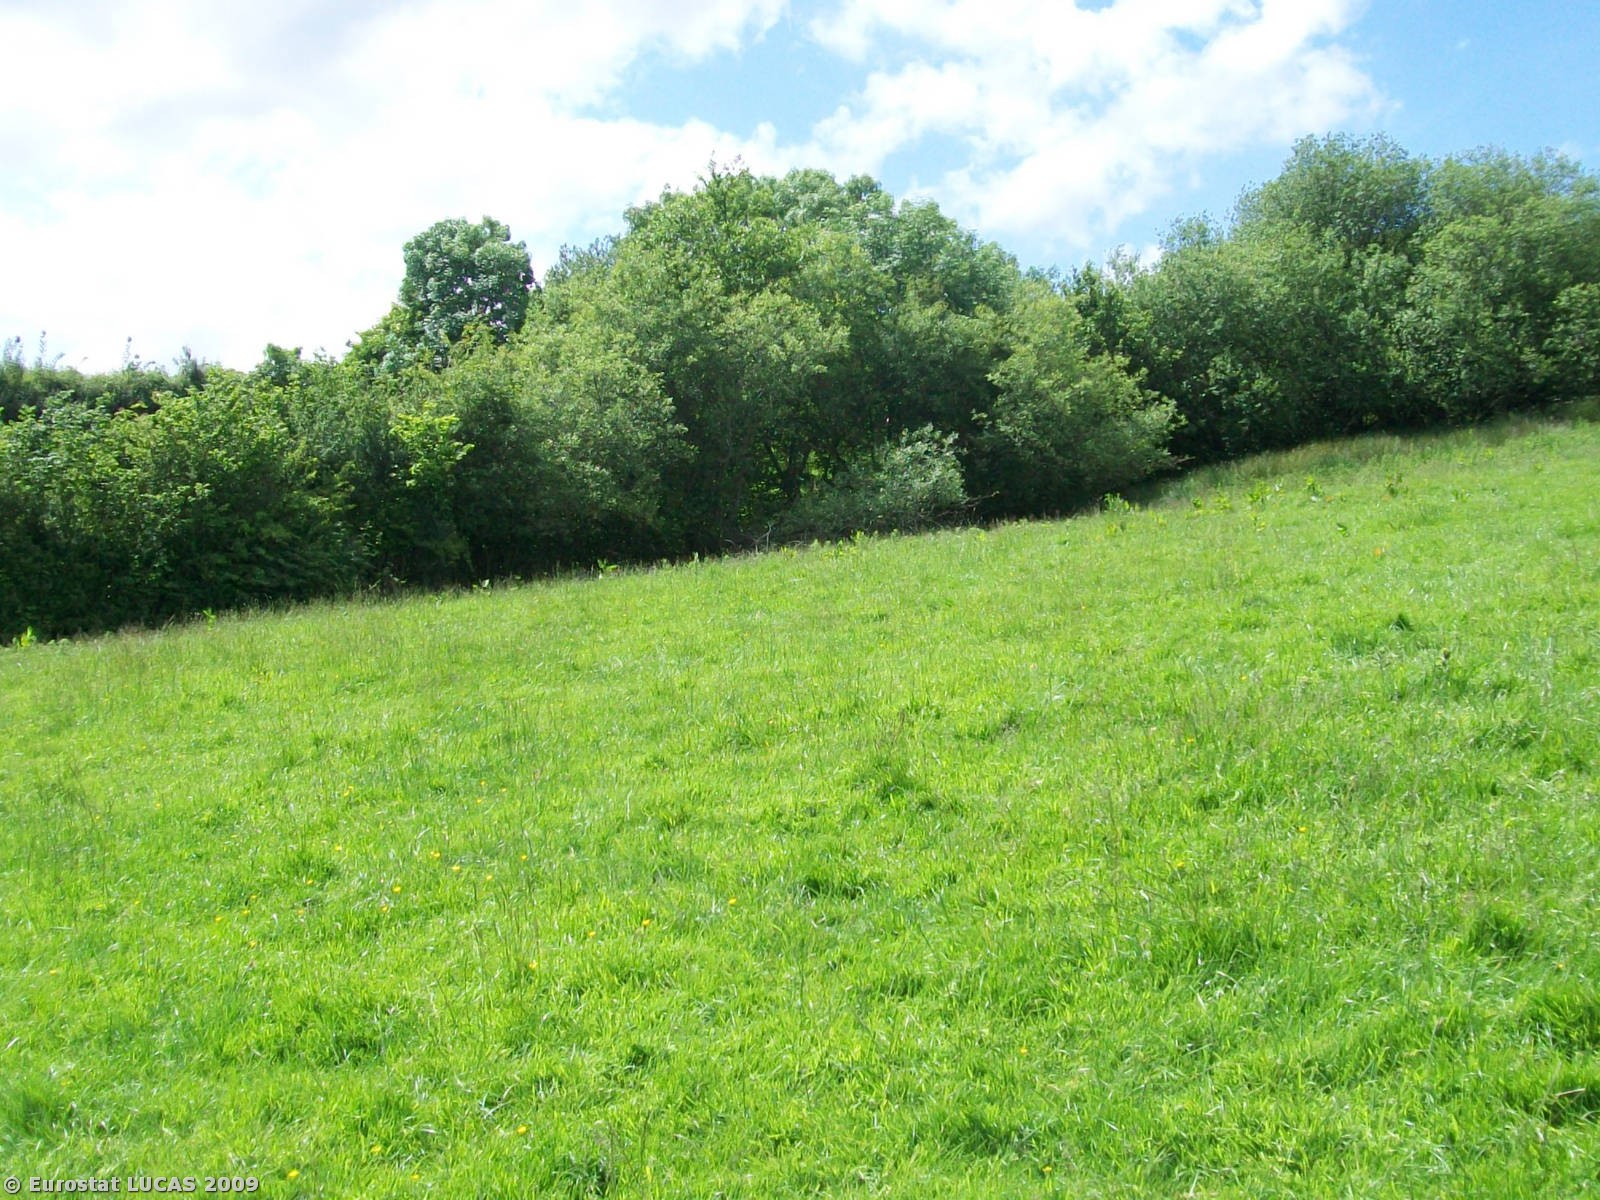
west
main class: Grassland
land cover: Grassland without tree/shrub cover
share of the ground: > 75 %
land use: Agriculture (excluding fallow land and kitchen gardens)
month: June
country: GB
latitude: 50.9510
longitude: -3.4495
